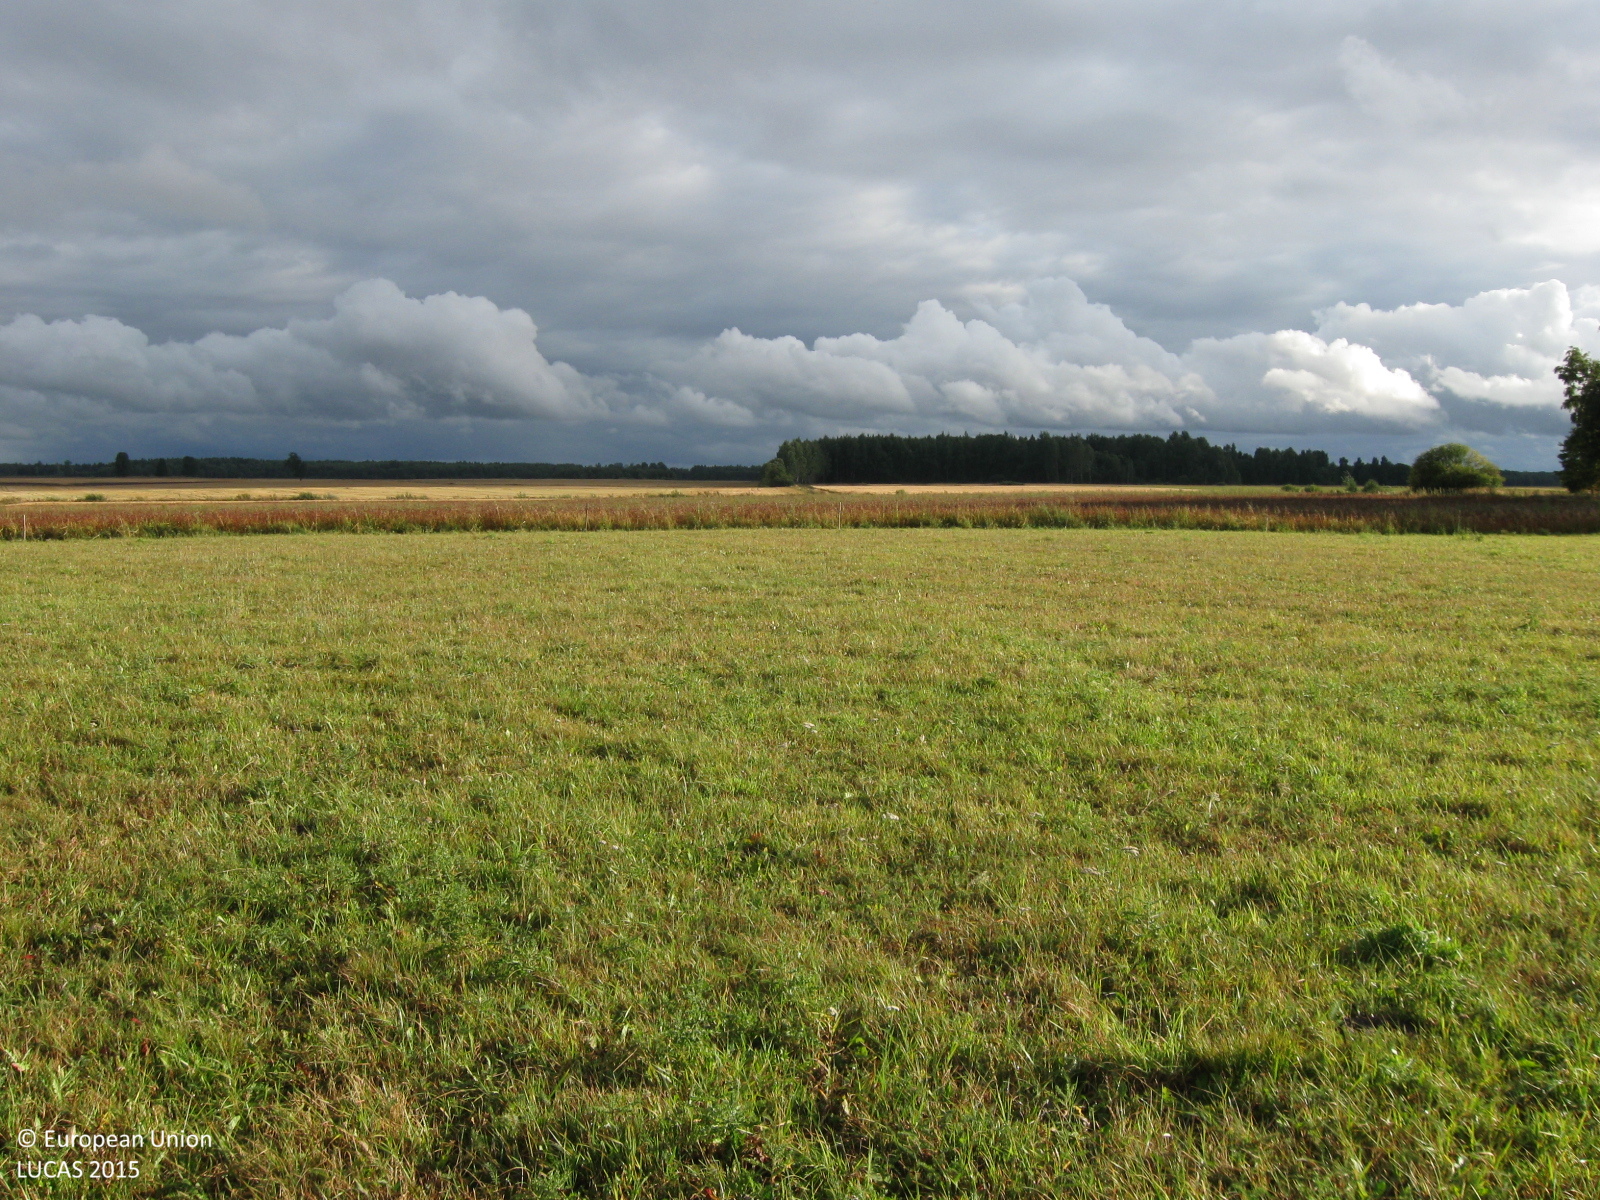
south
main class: Grassland
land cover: Grassland without tree/shrub cover
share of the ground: > 75 %
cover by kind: herbaceous plants 100 %
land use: Agriculture (excluding fallow land and kitchen gardens)
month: August
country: LT
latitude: 55.2599
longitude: 23.2451
